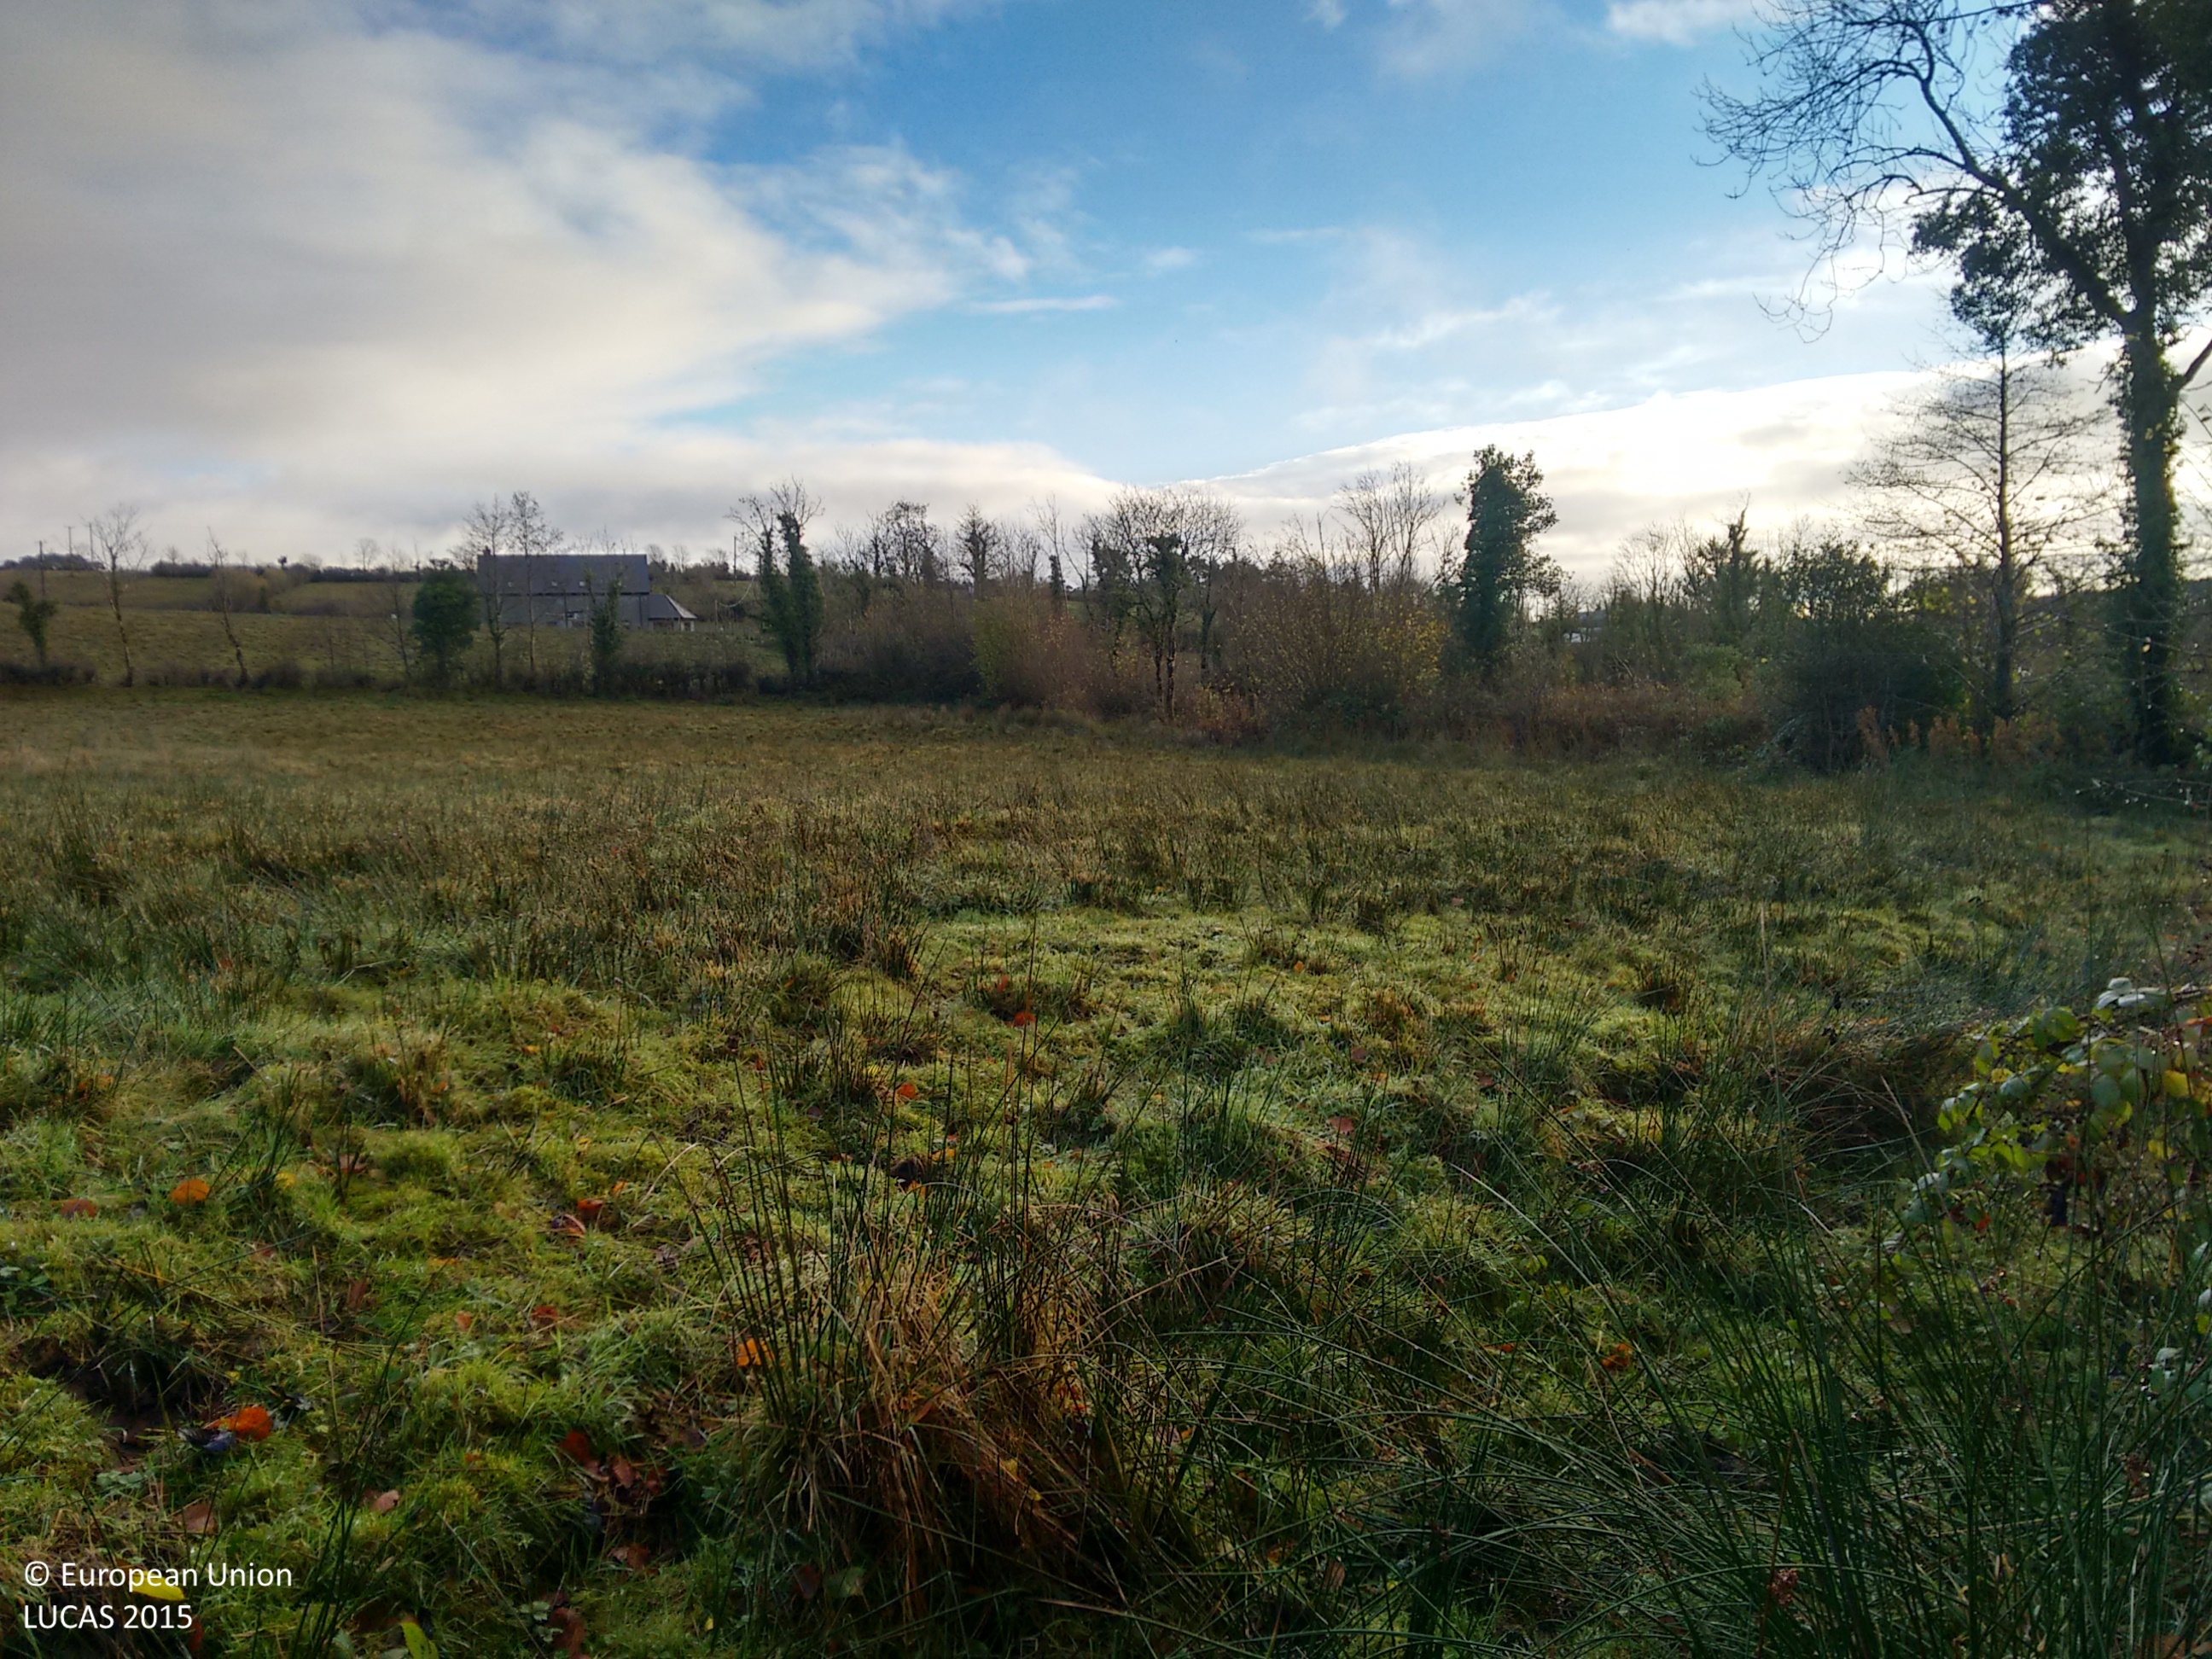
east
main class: Woodland
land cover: Broadleaved woodland
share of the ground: > 75 %
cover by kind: broadleaved forest trees 95 %, shrubs 5 %
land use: Agriculture (excluding fallow land and kitchen gardens)
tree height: > 5 m
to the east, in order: Broadleaved woodland; Ditches and canals; Broadleaved woodland; Fences; Grassland without tree/shrub cover; Fences; Ditches and canals; Abandoned hedges; Grassland without tree/shrub cover; Abandoned hedges; Grassland without tree/shrub cover; Abandoned hedges; Grassland without tree/shrub cover; Abandoned hedges; Ditches and canals; Grassland without tree/shrub cover; Fences; Ditches and canals; Managed hedges; Artificial constructions in urban areas
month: November
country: IE
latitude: 54.0013
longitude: -7.8192
